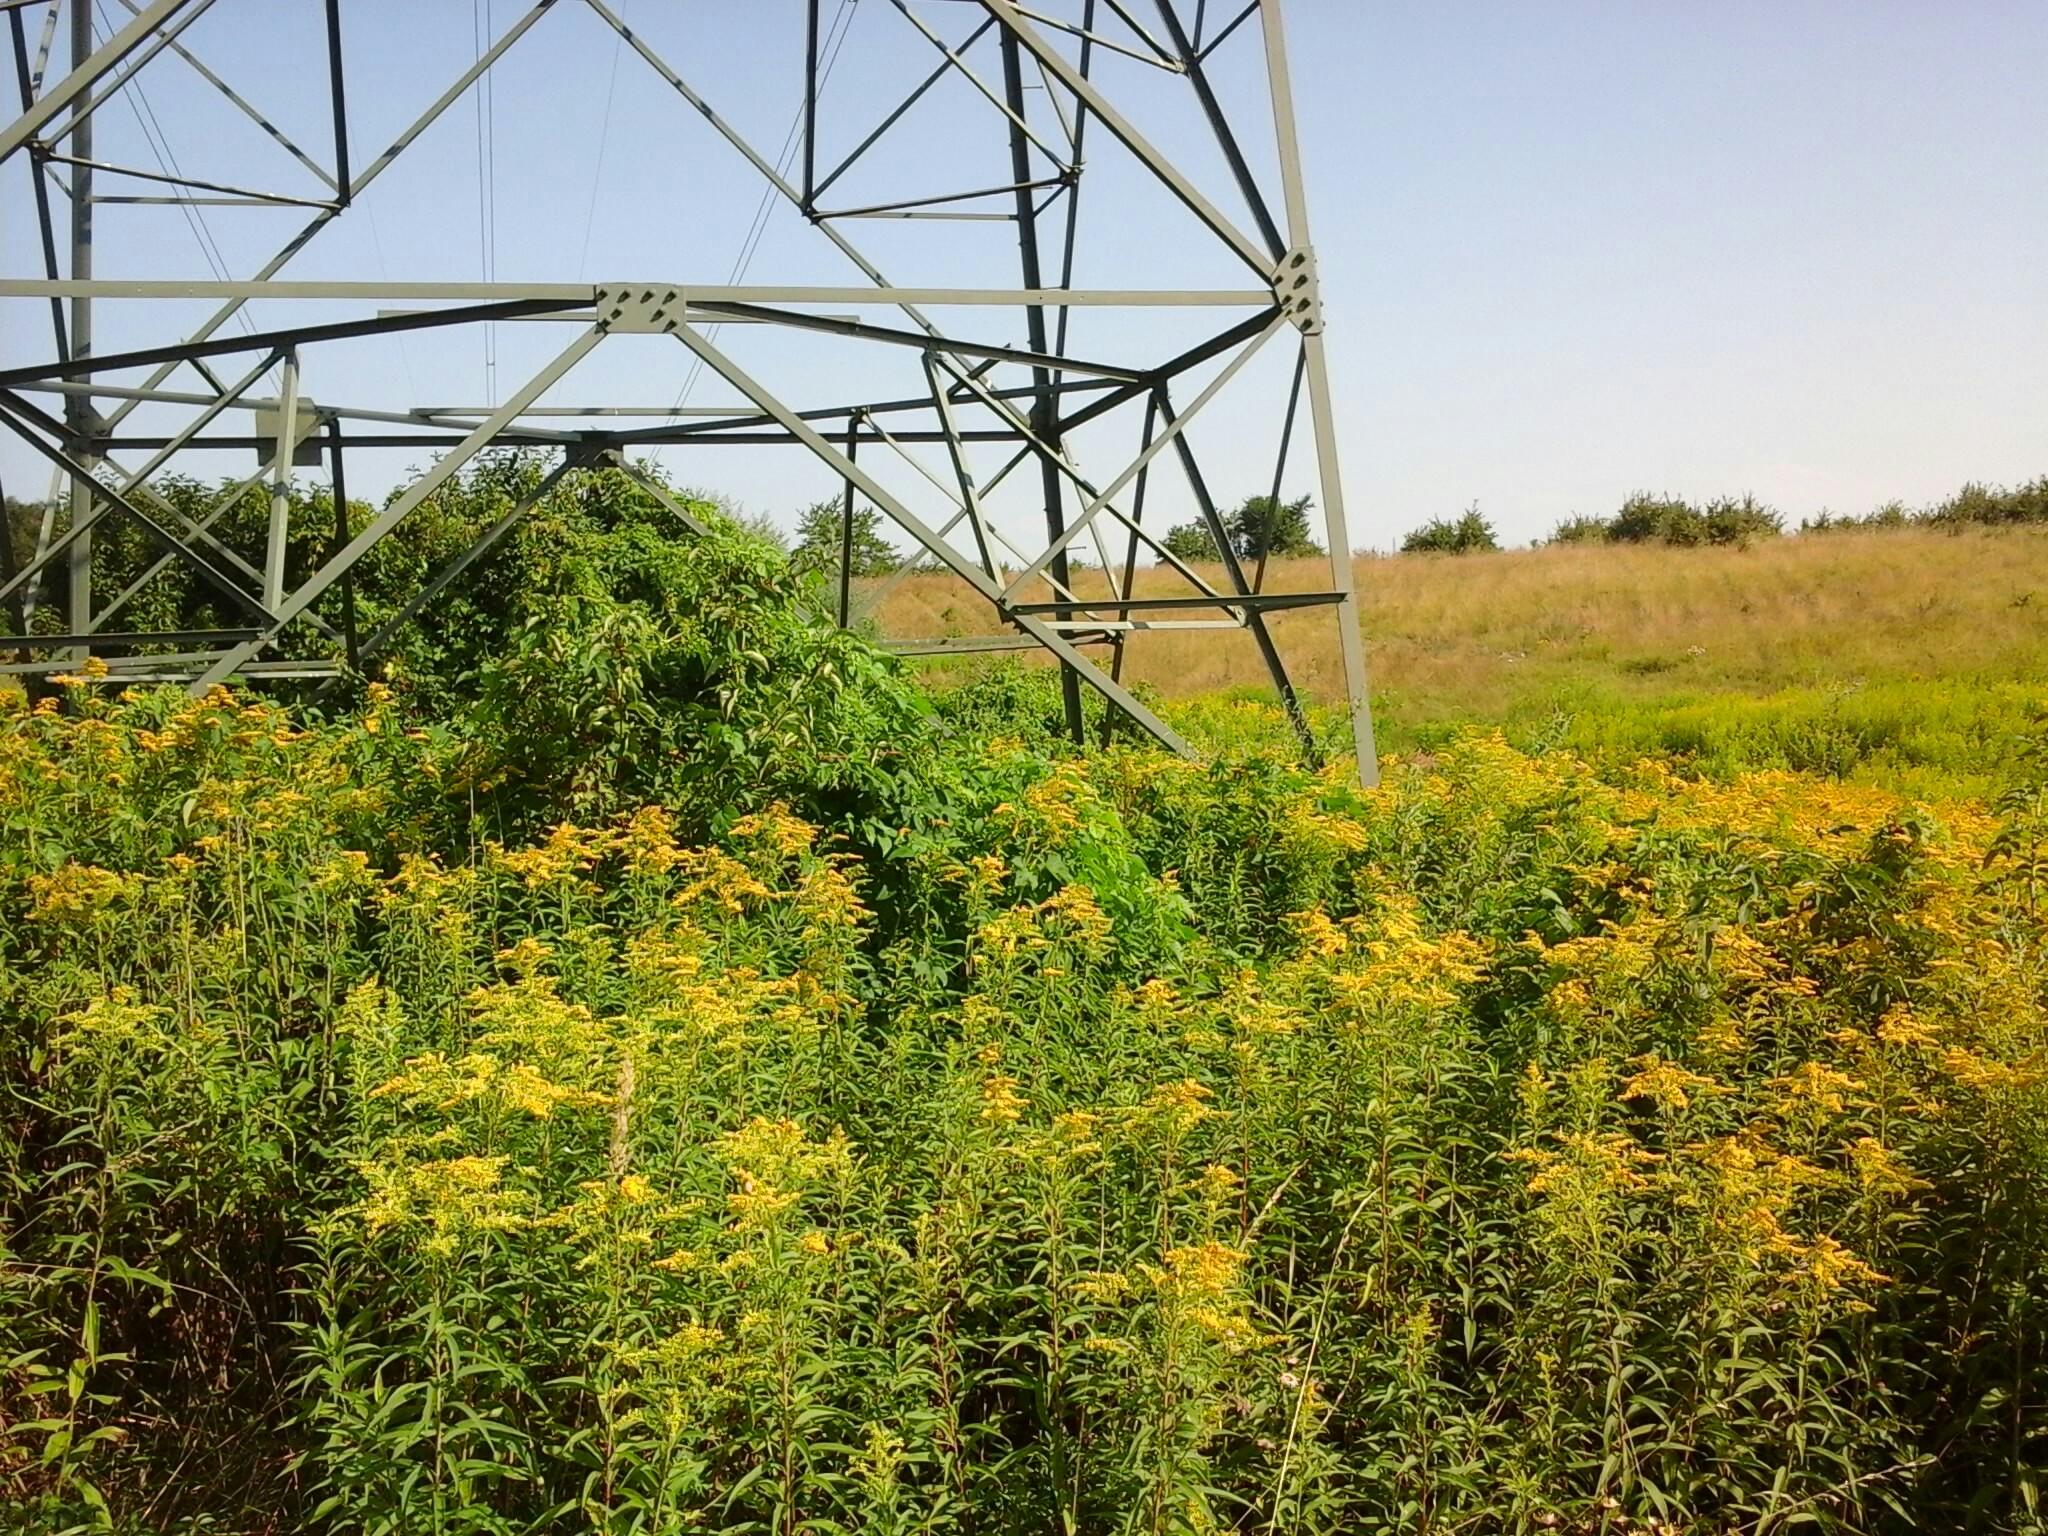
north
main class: Grassland
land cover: Grassland without tree/shrub cover
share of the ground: > 75 %
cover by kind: herbaceous plants 95 %, shrubs 5 %
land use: Agriculture (excluding fallow land and kitchen gardens)
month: August
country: HU
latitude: 47.4515
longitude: 17.9015
